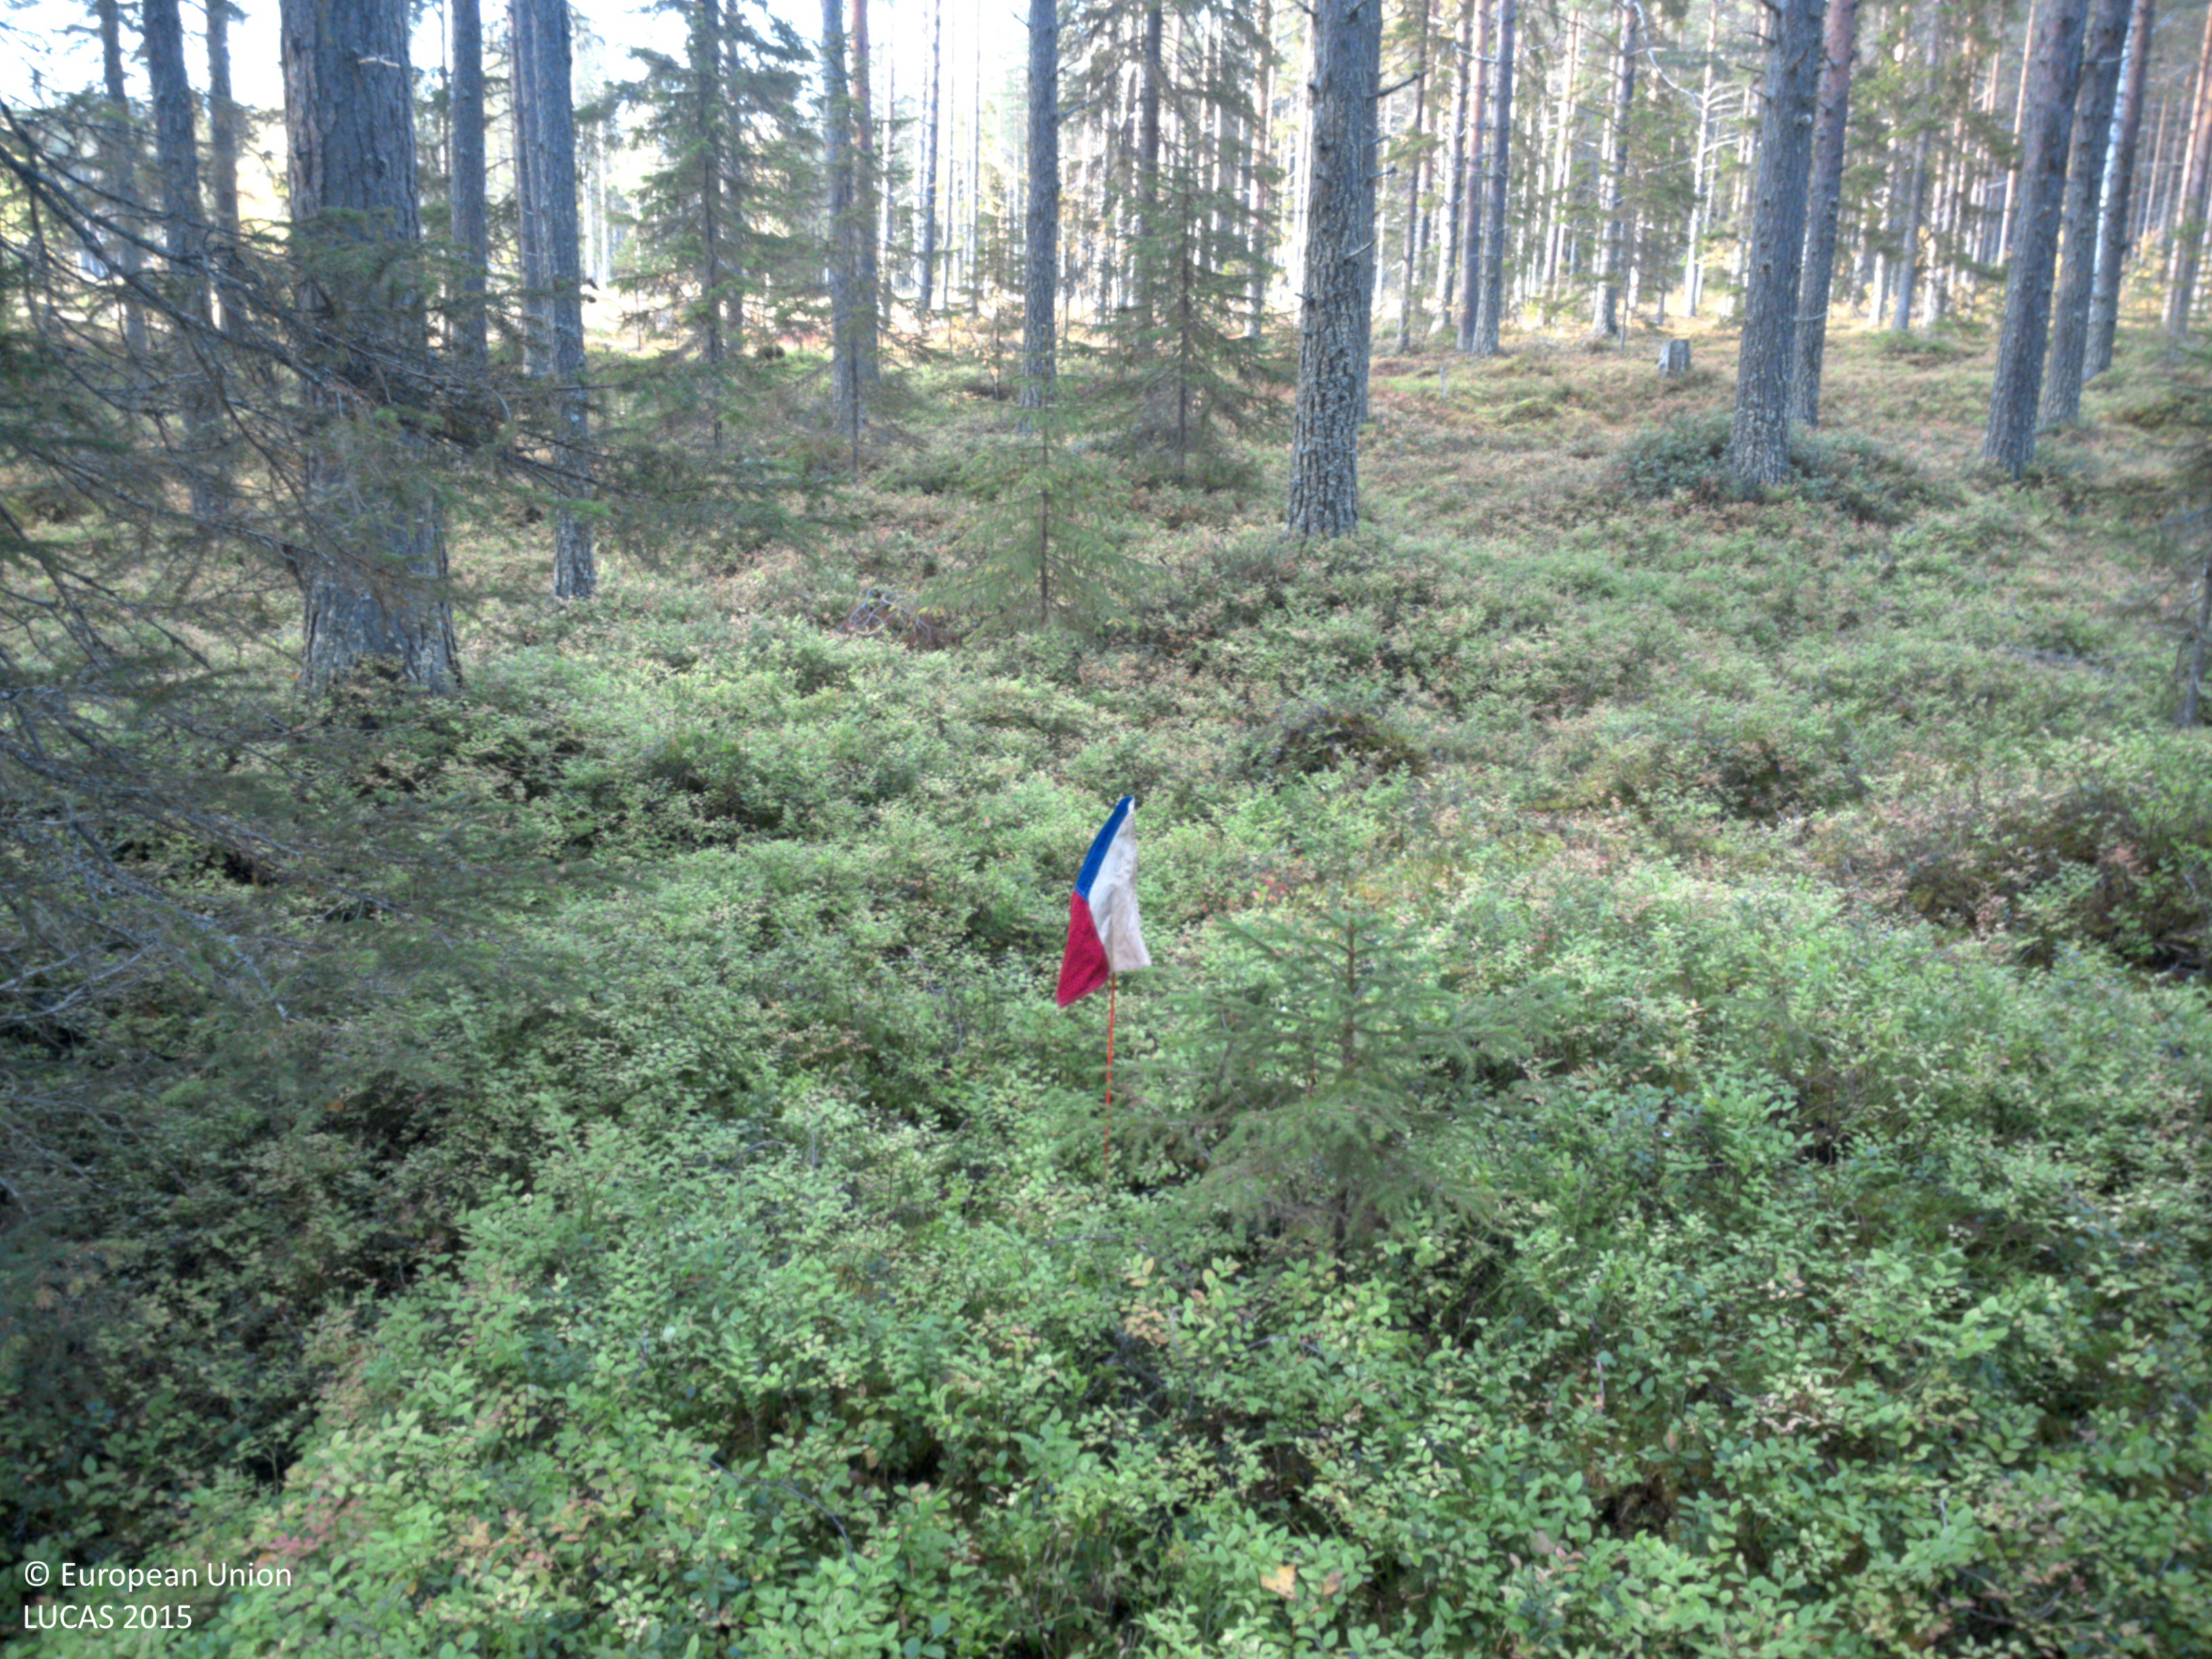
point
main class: Woodland
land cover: Other coniferous woodland
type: boreal forest
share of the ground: > 75 %
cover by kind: coniferous forest trees 70 %, shrubs 25 %, broadleaved forest trees 5 %
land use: Forestry
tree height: > 5 m
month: September
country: SE
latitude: 64.8109
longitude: 19.0854
